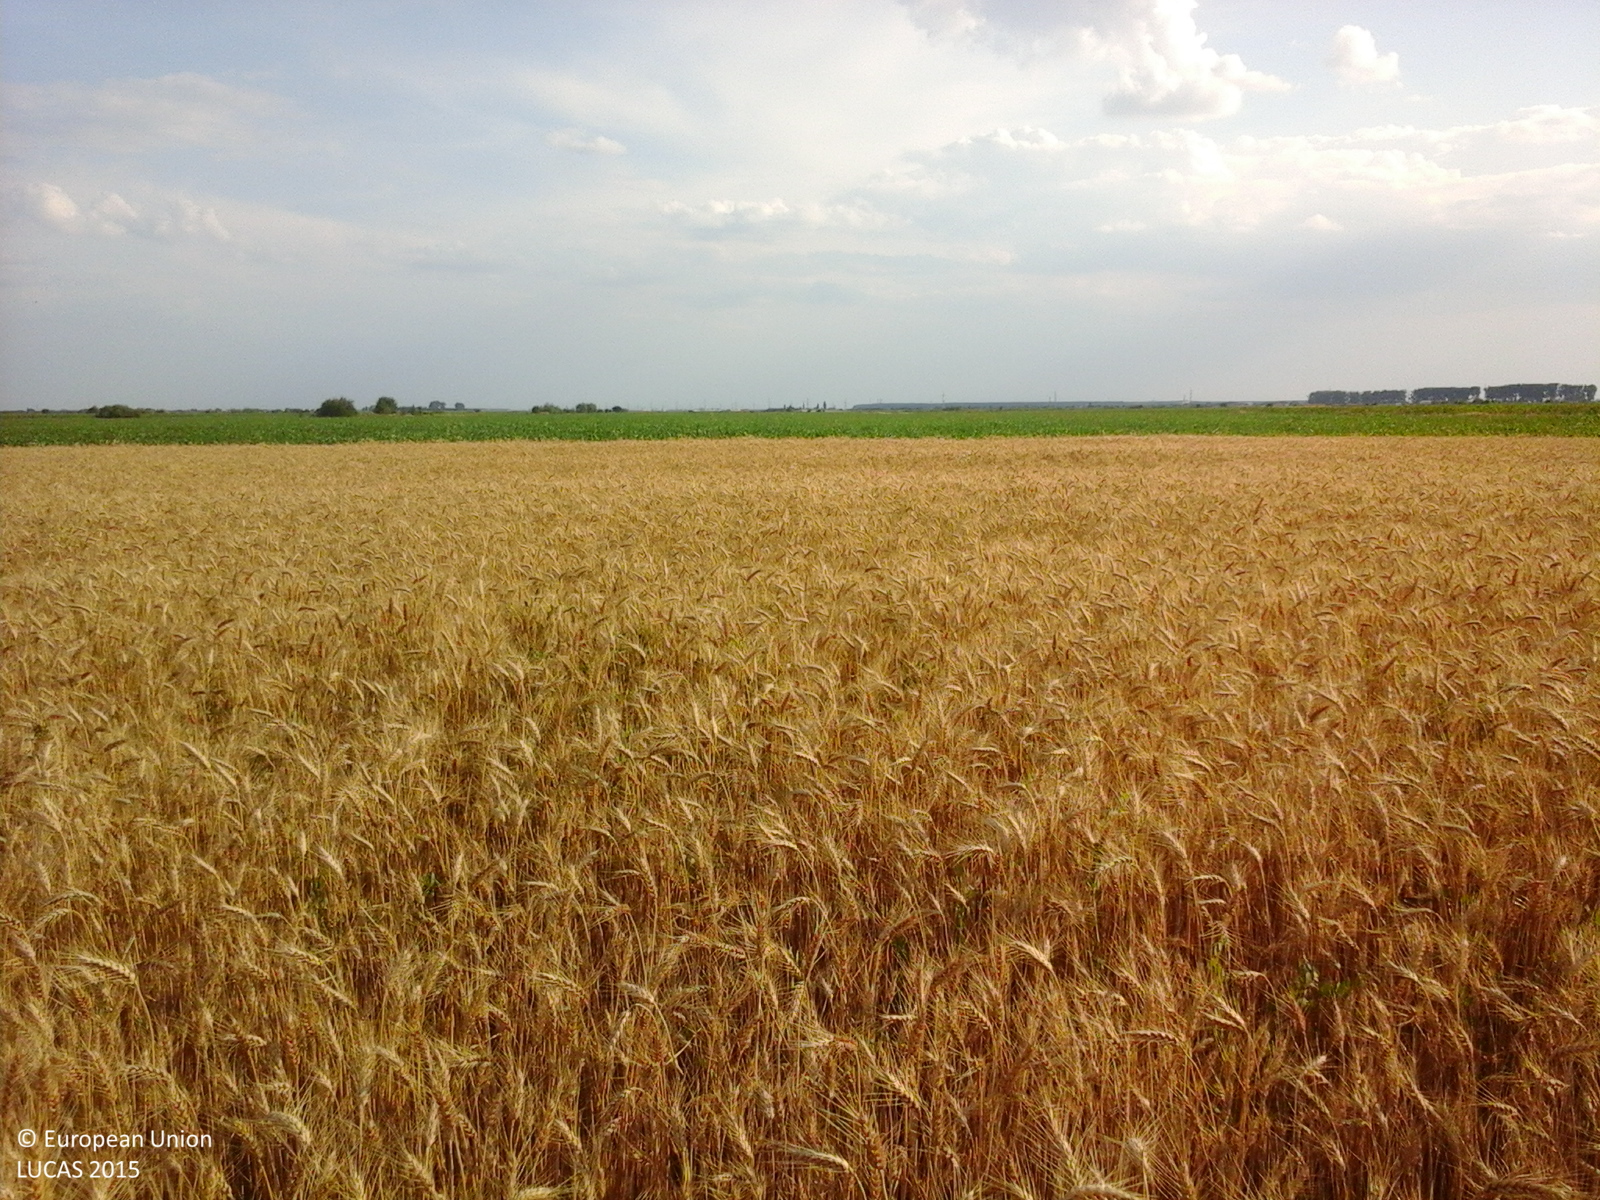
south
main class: Cropland
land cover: Common wheat
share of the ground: > 75 %
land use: Agriculture (excluding fallow land and kitchen gardens)
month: June
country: RO
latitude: 44.5671
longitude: 26.2394
